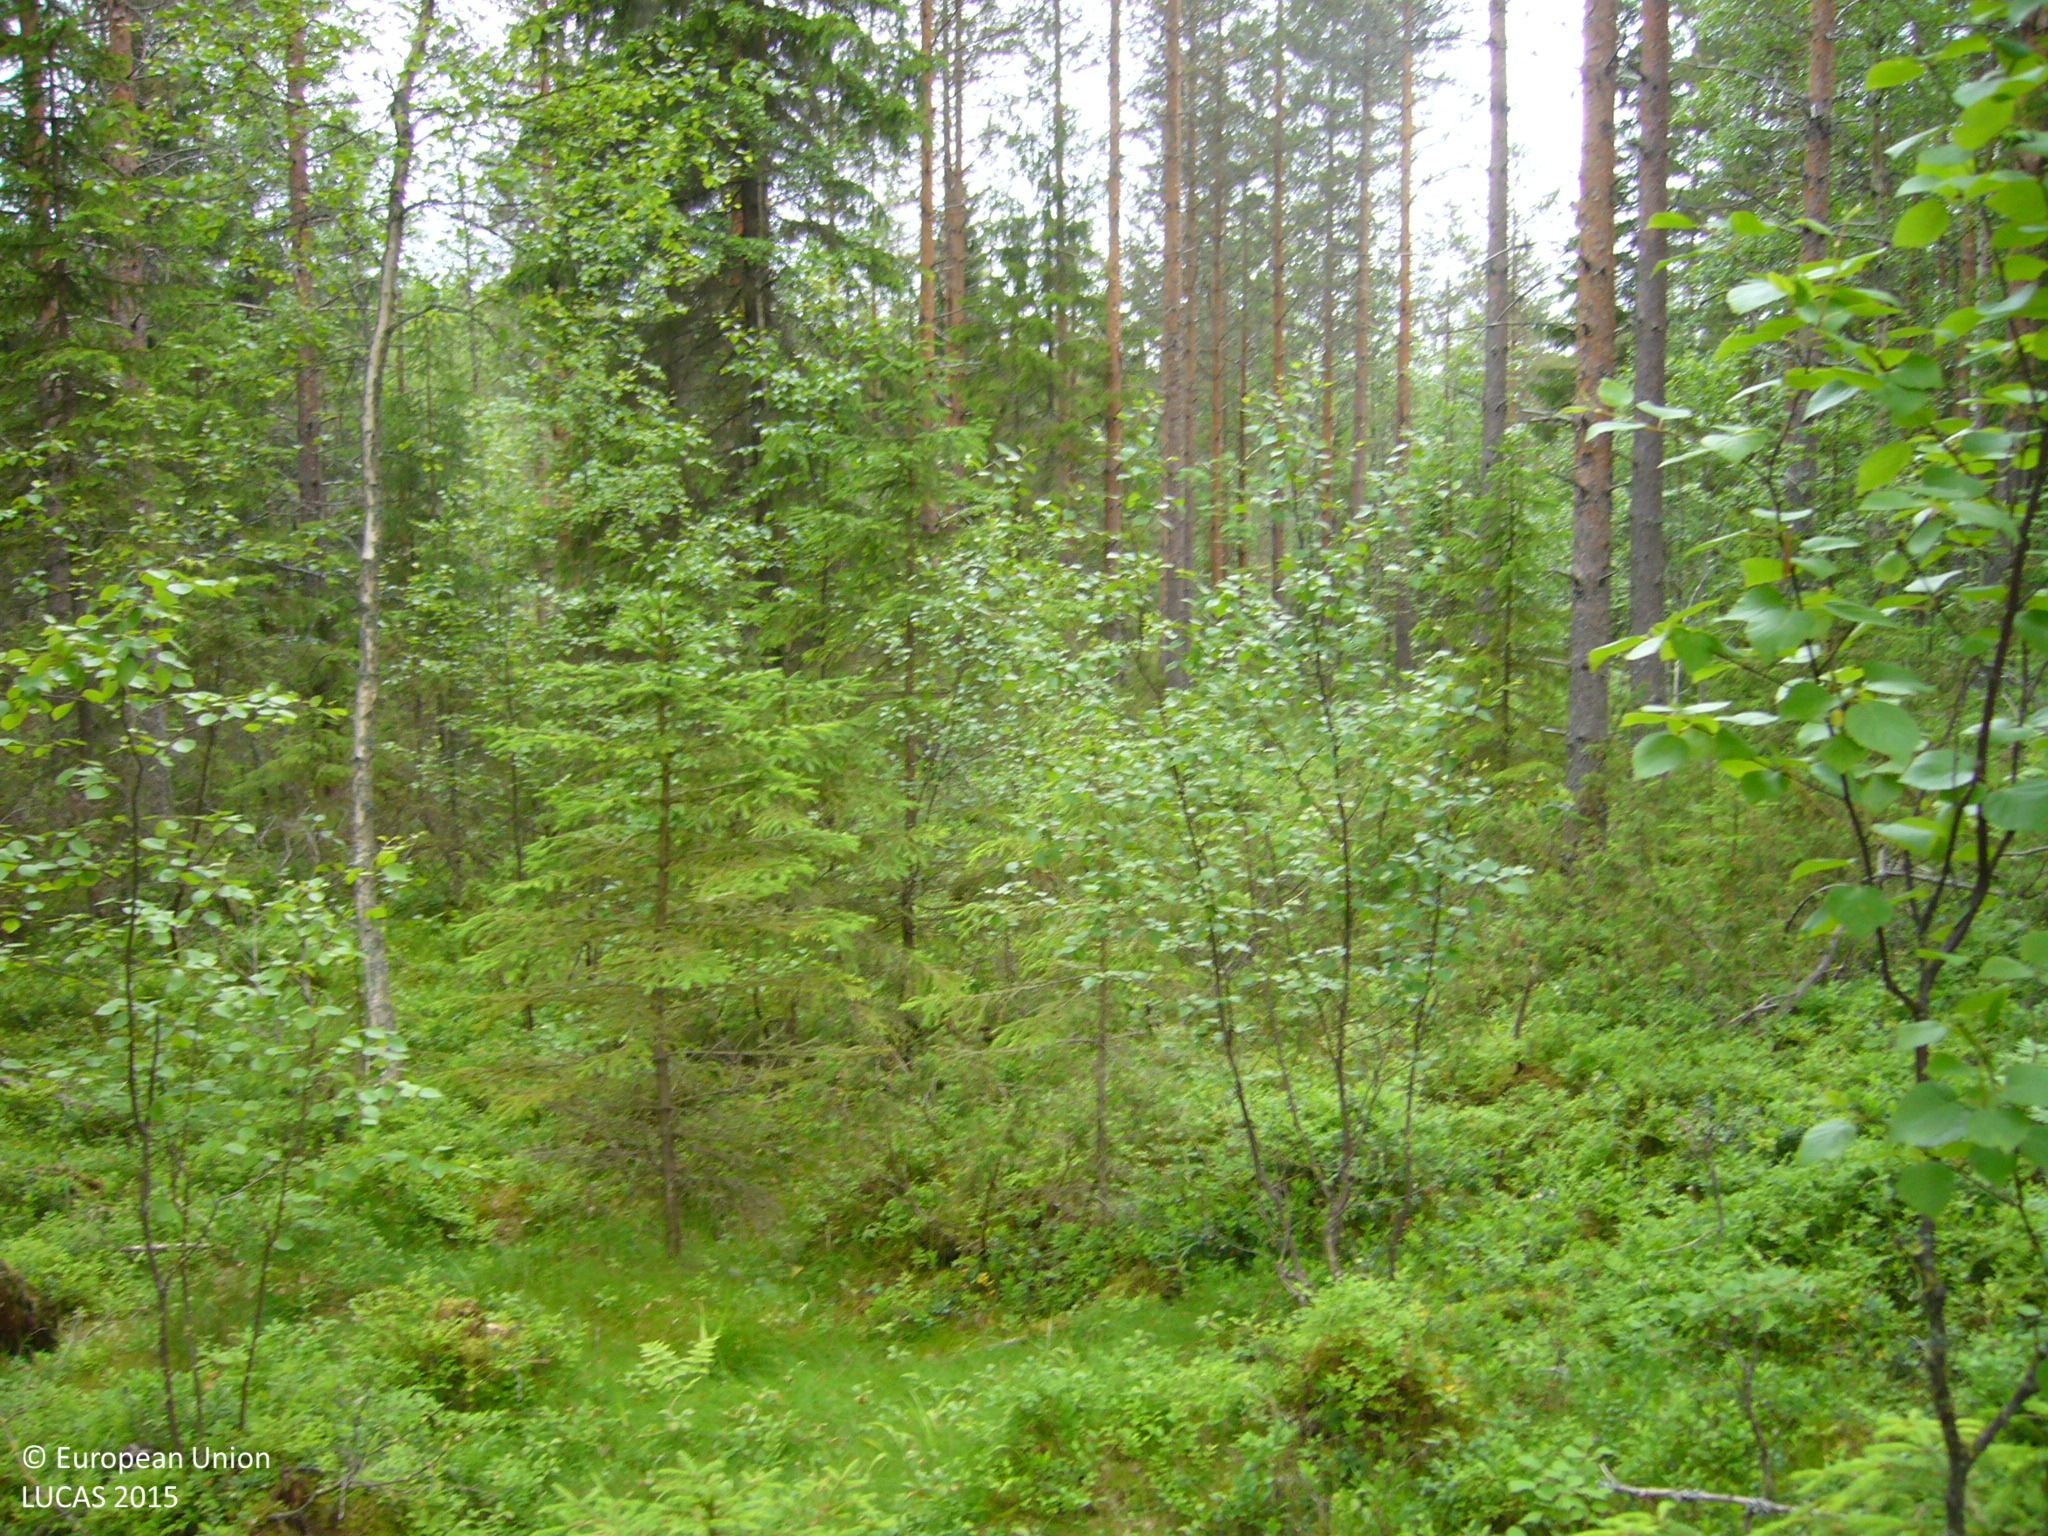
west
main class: Woodland
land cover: Pine dominated coniferous woodland
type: boreal forest
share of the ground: > 75 %
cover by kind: coniferous forest trees 70 %, shrubs 20 %, broadleaved forest trees 10 %
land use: Forestry
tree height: > 5 m
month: July
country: FI
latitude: 63.2910
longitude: 26.0920
